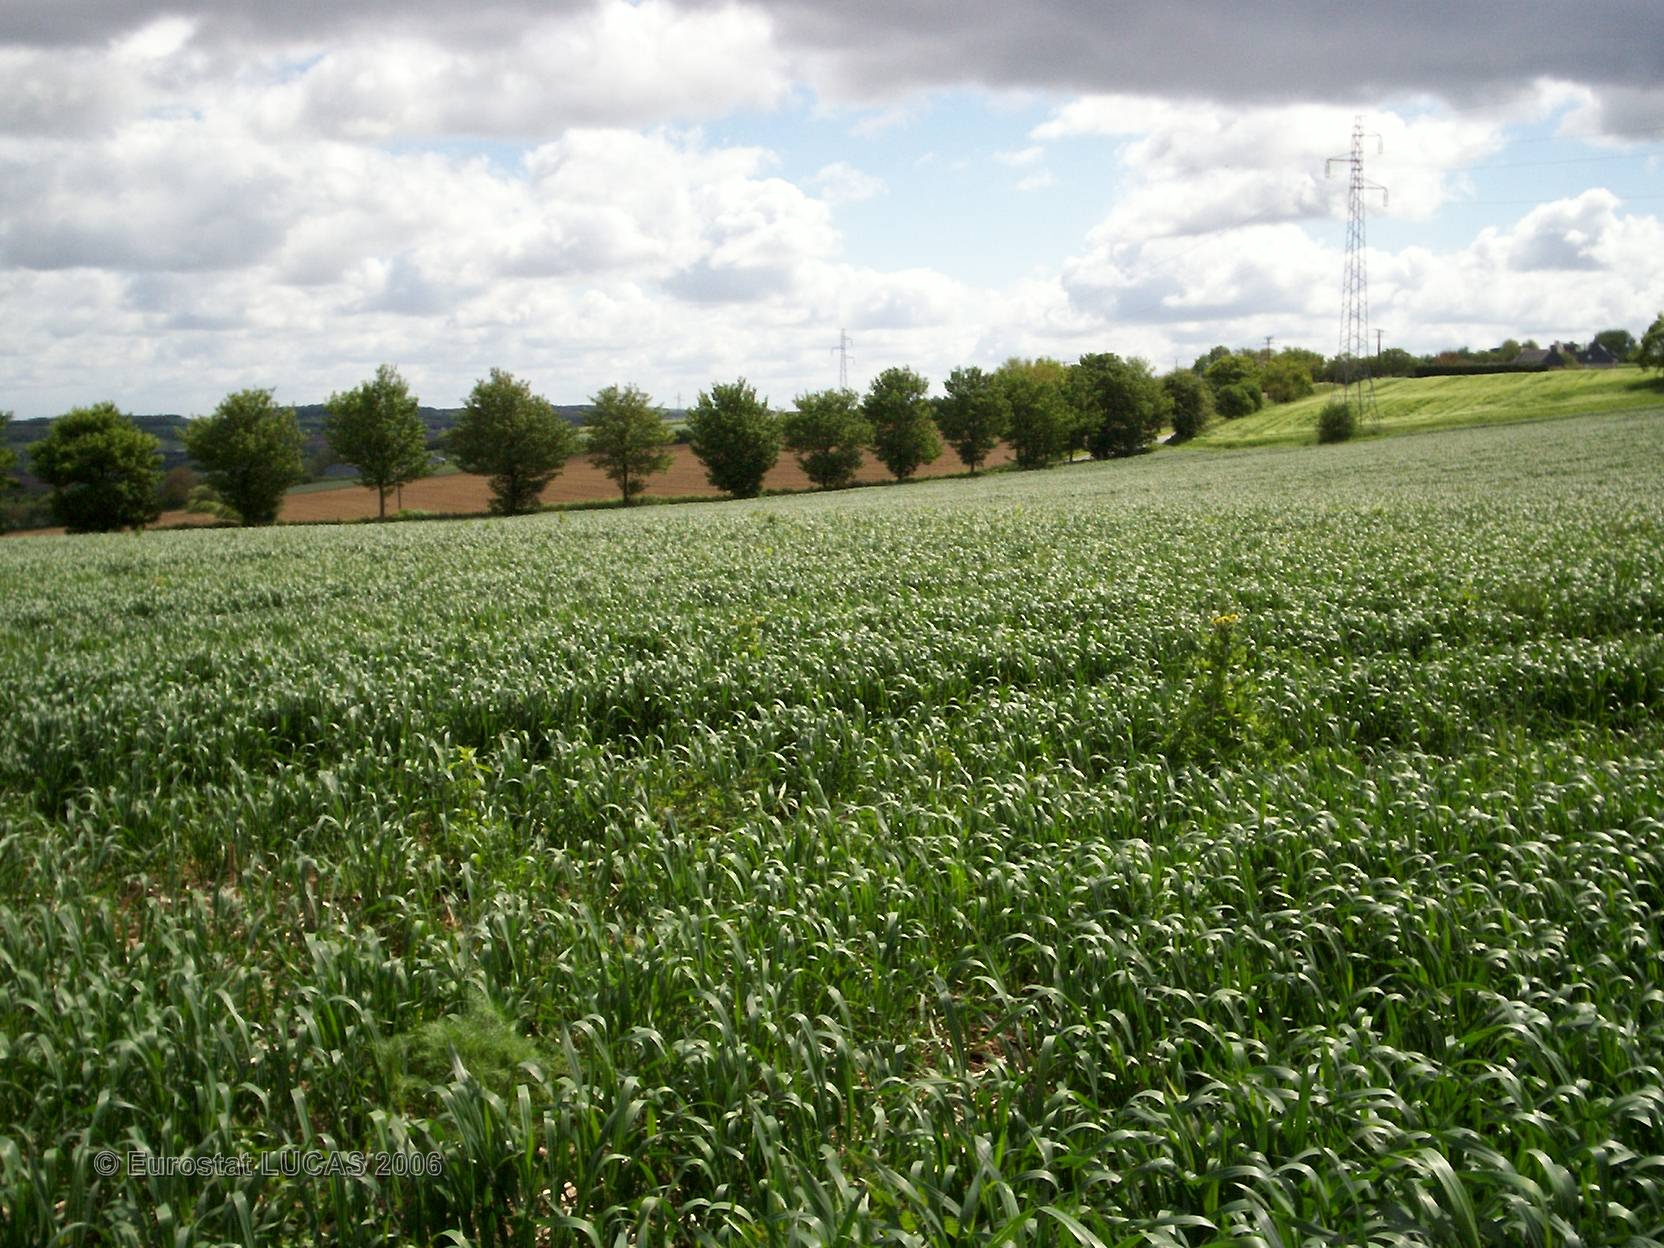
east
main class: Cropland
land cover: Common wheat
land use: Agriculture (excluding fallow land and kitchen gardens)
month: May
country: FR
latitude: 48.2805
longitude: -2.9098
